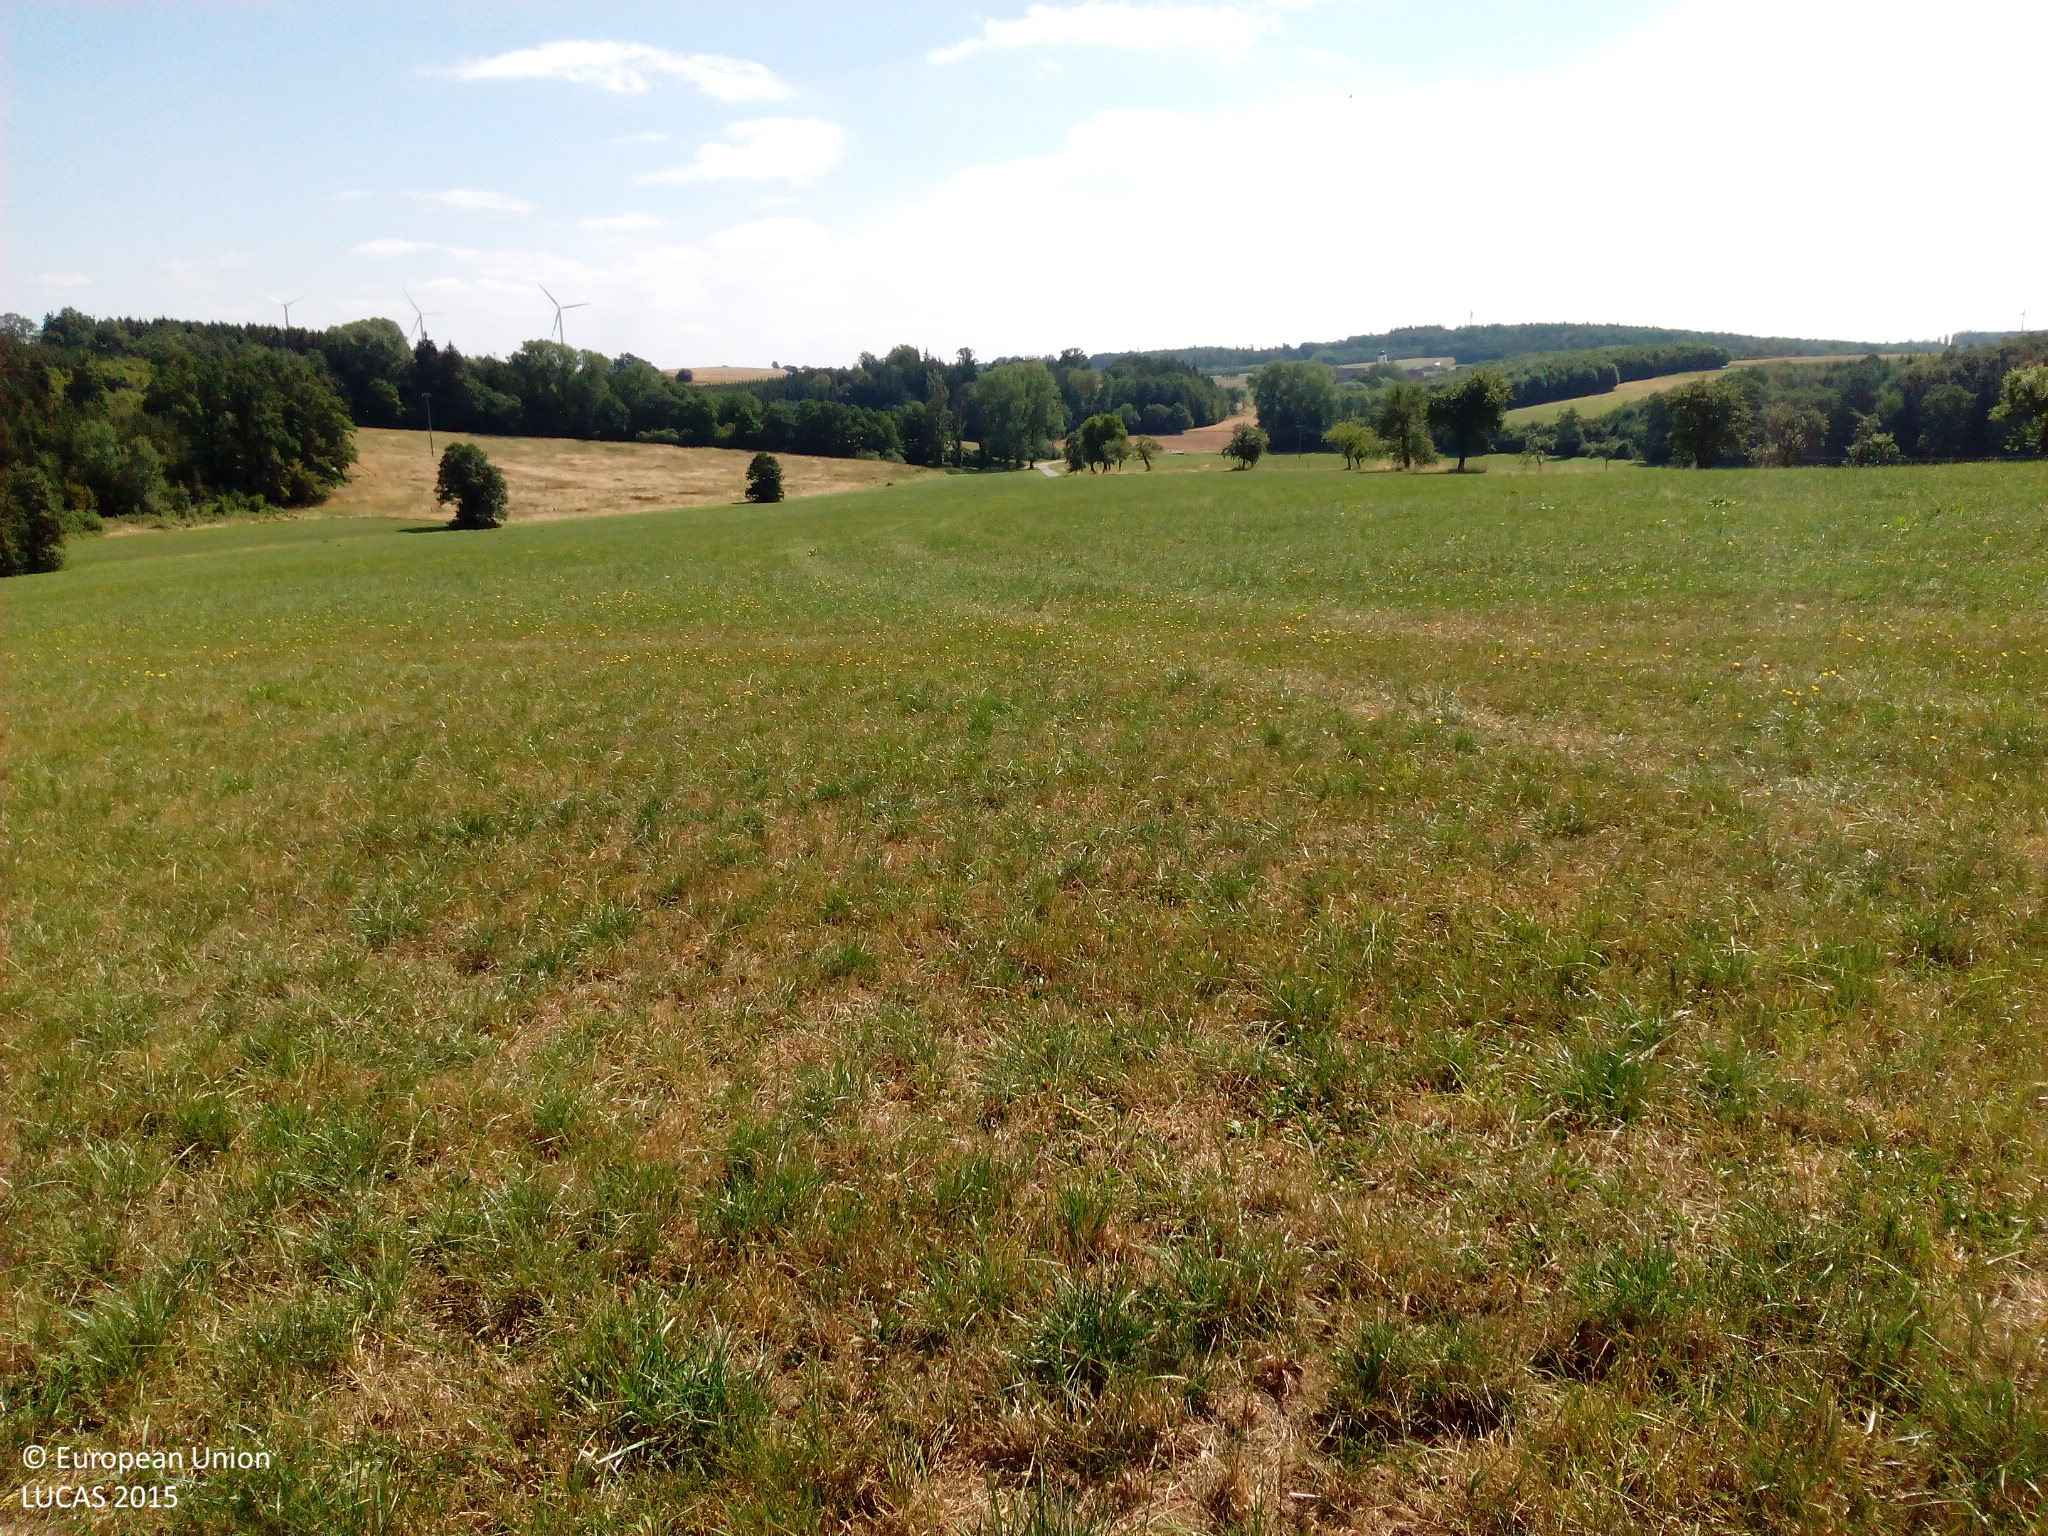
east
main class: Grassland
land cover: Grassland without tree/shrub cover
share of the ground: > 75 %
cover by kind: herbaceous plants 90 %, unconsolidated bare surface 10 %
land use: Agriculture (excluding fallow land and kitchen gardens)
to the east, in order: Grassland without tree/shrub cover
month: August
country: DE
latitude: 48.9789
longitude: 10.2595
